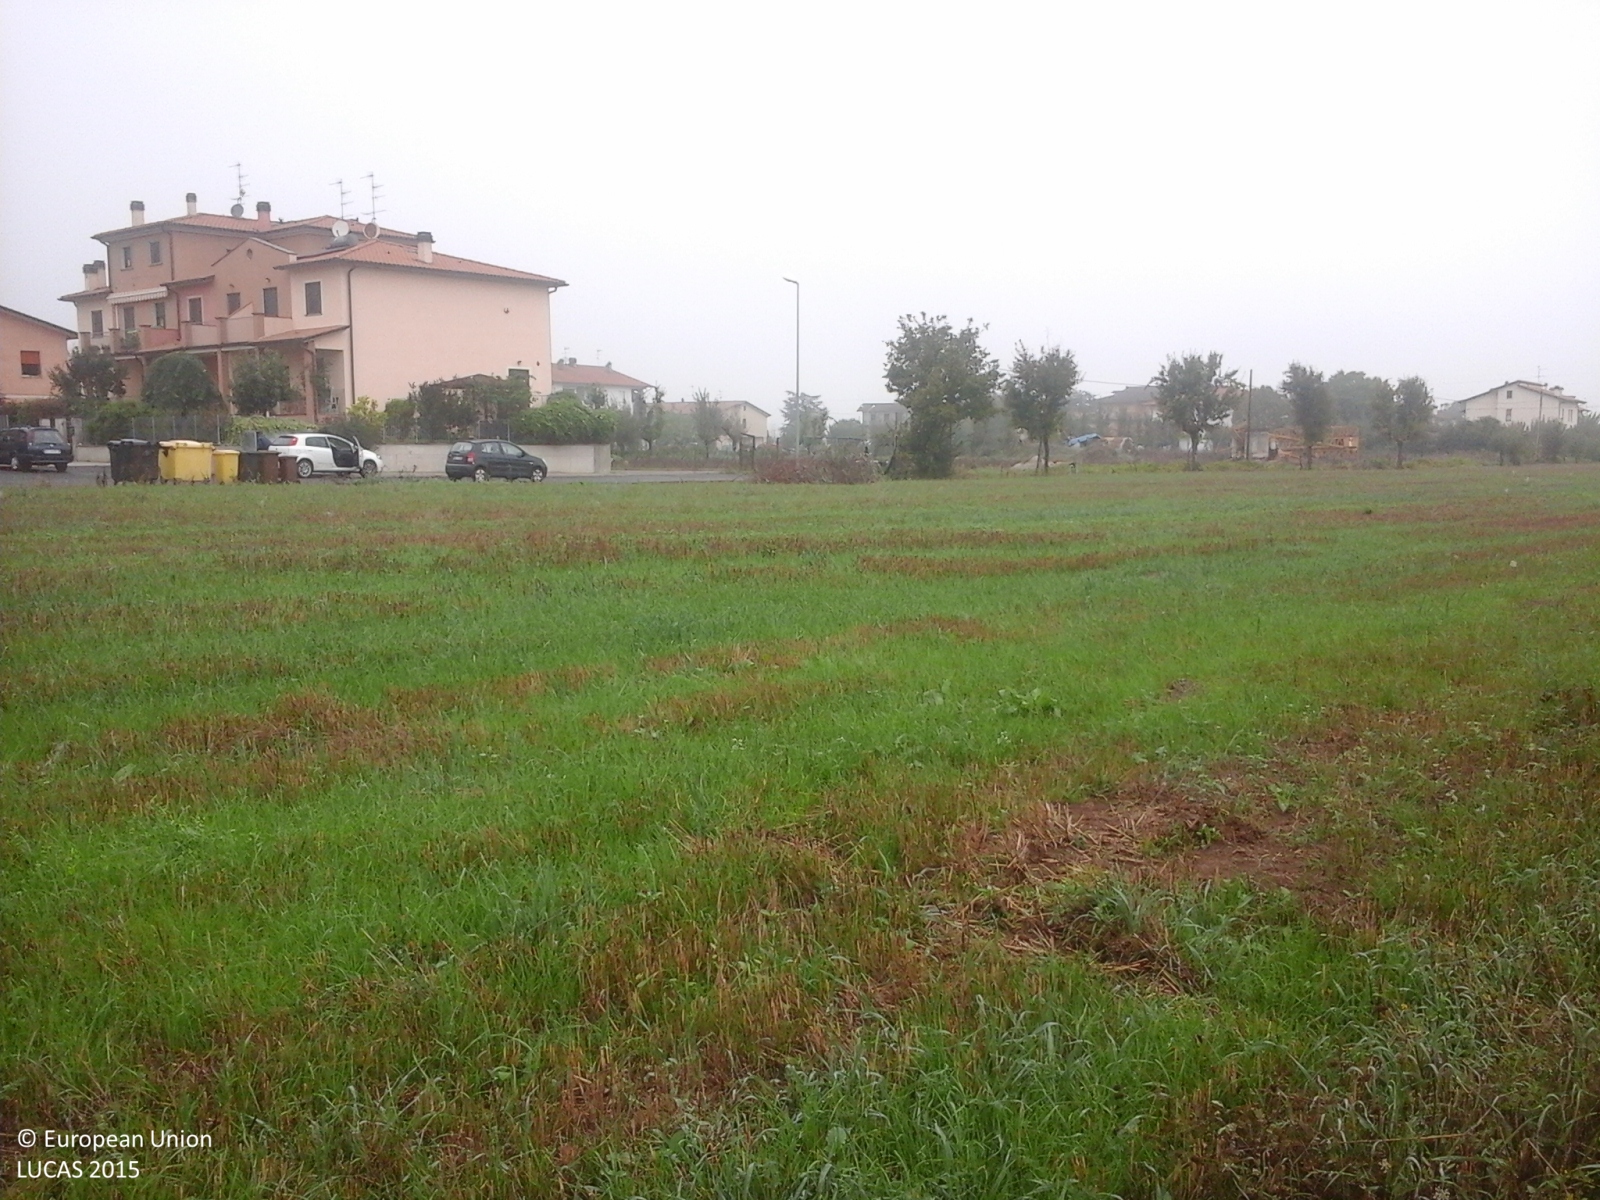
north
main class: Cropland
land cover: Tobacco
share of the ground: > 75 %
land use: Agriculture (excluding fallow land and kitchen gardens)
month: October
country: IT
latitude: 43.5170
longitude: 12.1098
